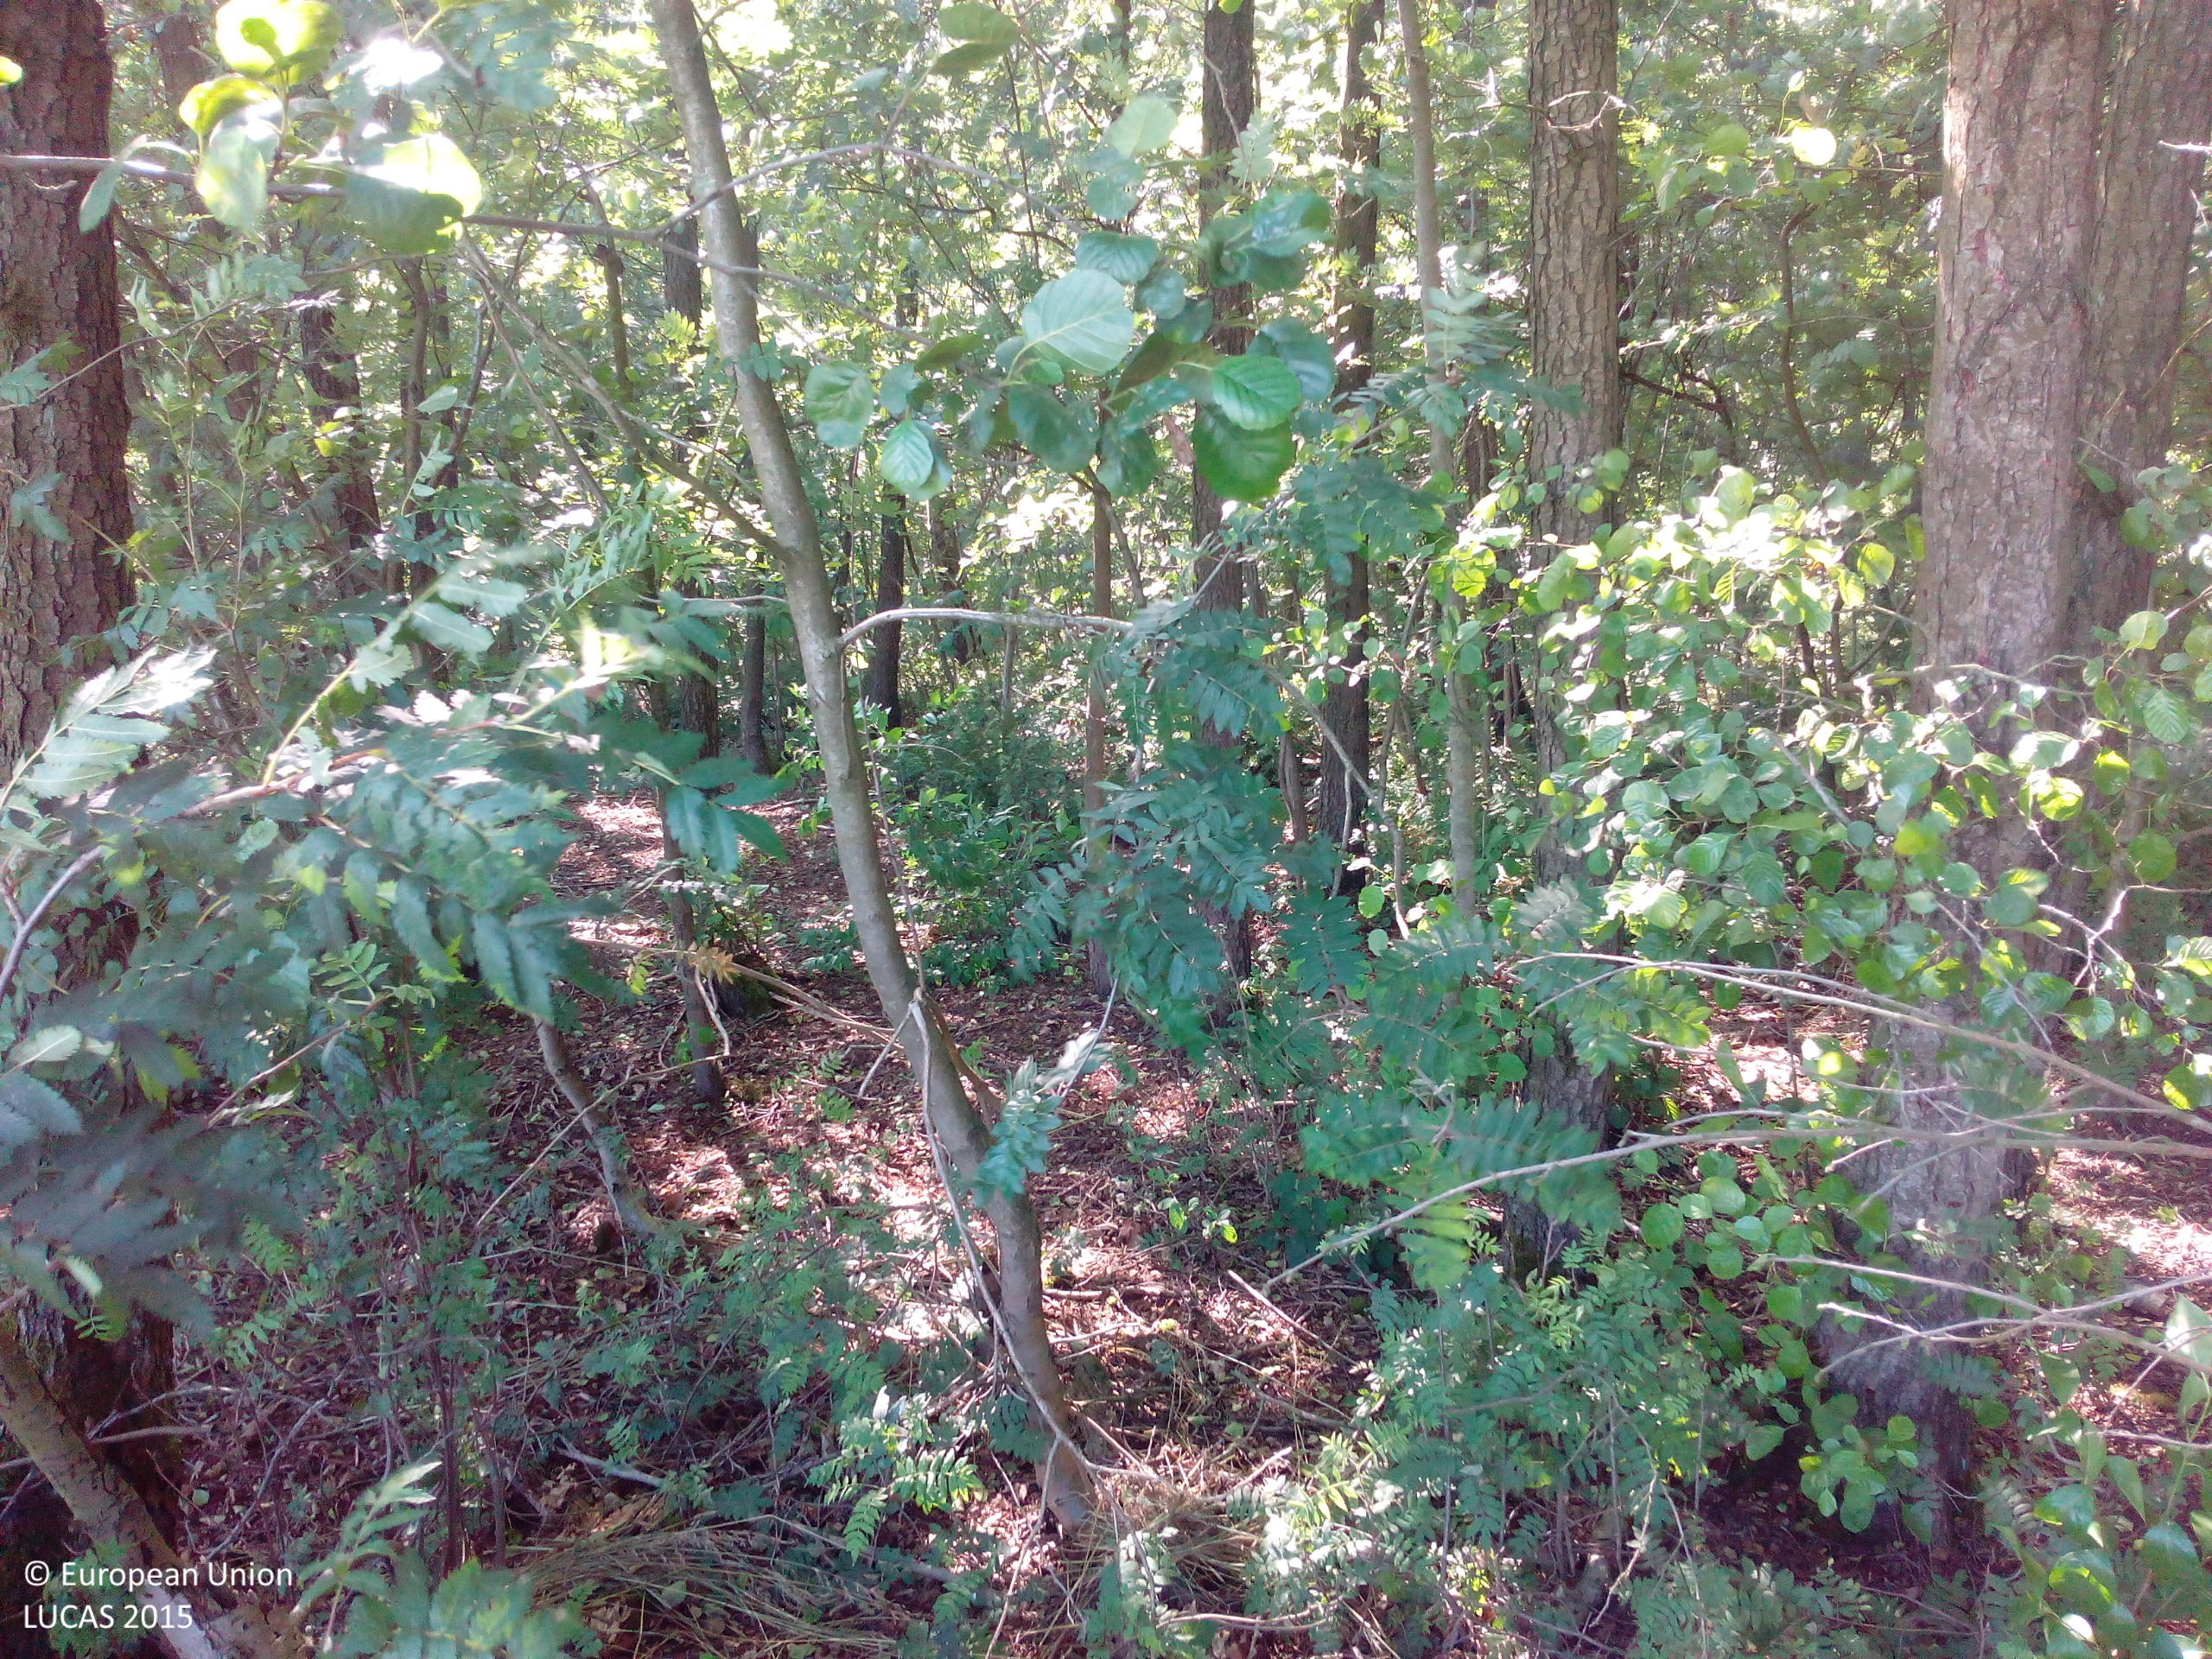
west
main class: Woodland
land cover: Broadleaved woodland
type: non-riverine alder, birch or aspen forest
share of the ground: > 75 %
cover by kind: broadleaved forest trees 100 %
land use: Forestry
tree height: > 5 m
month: July
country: DE
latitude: 52.6647
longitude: 10.2808
